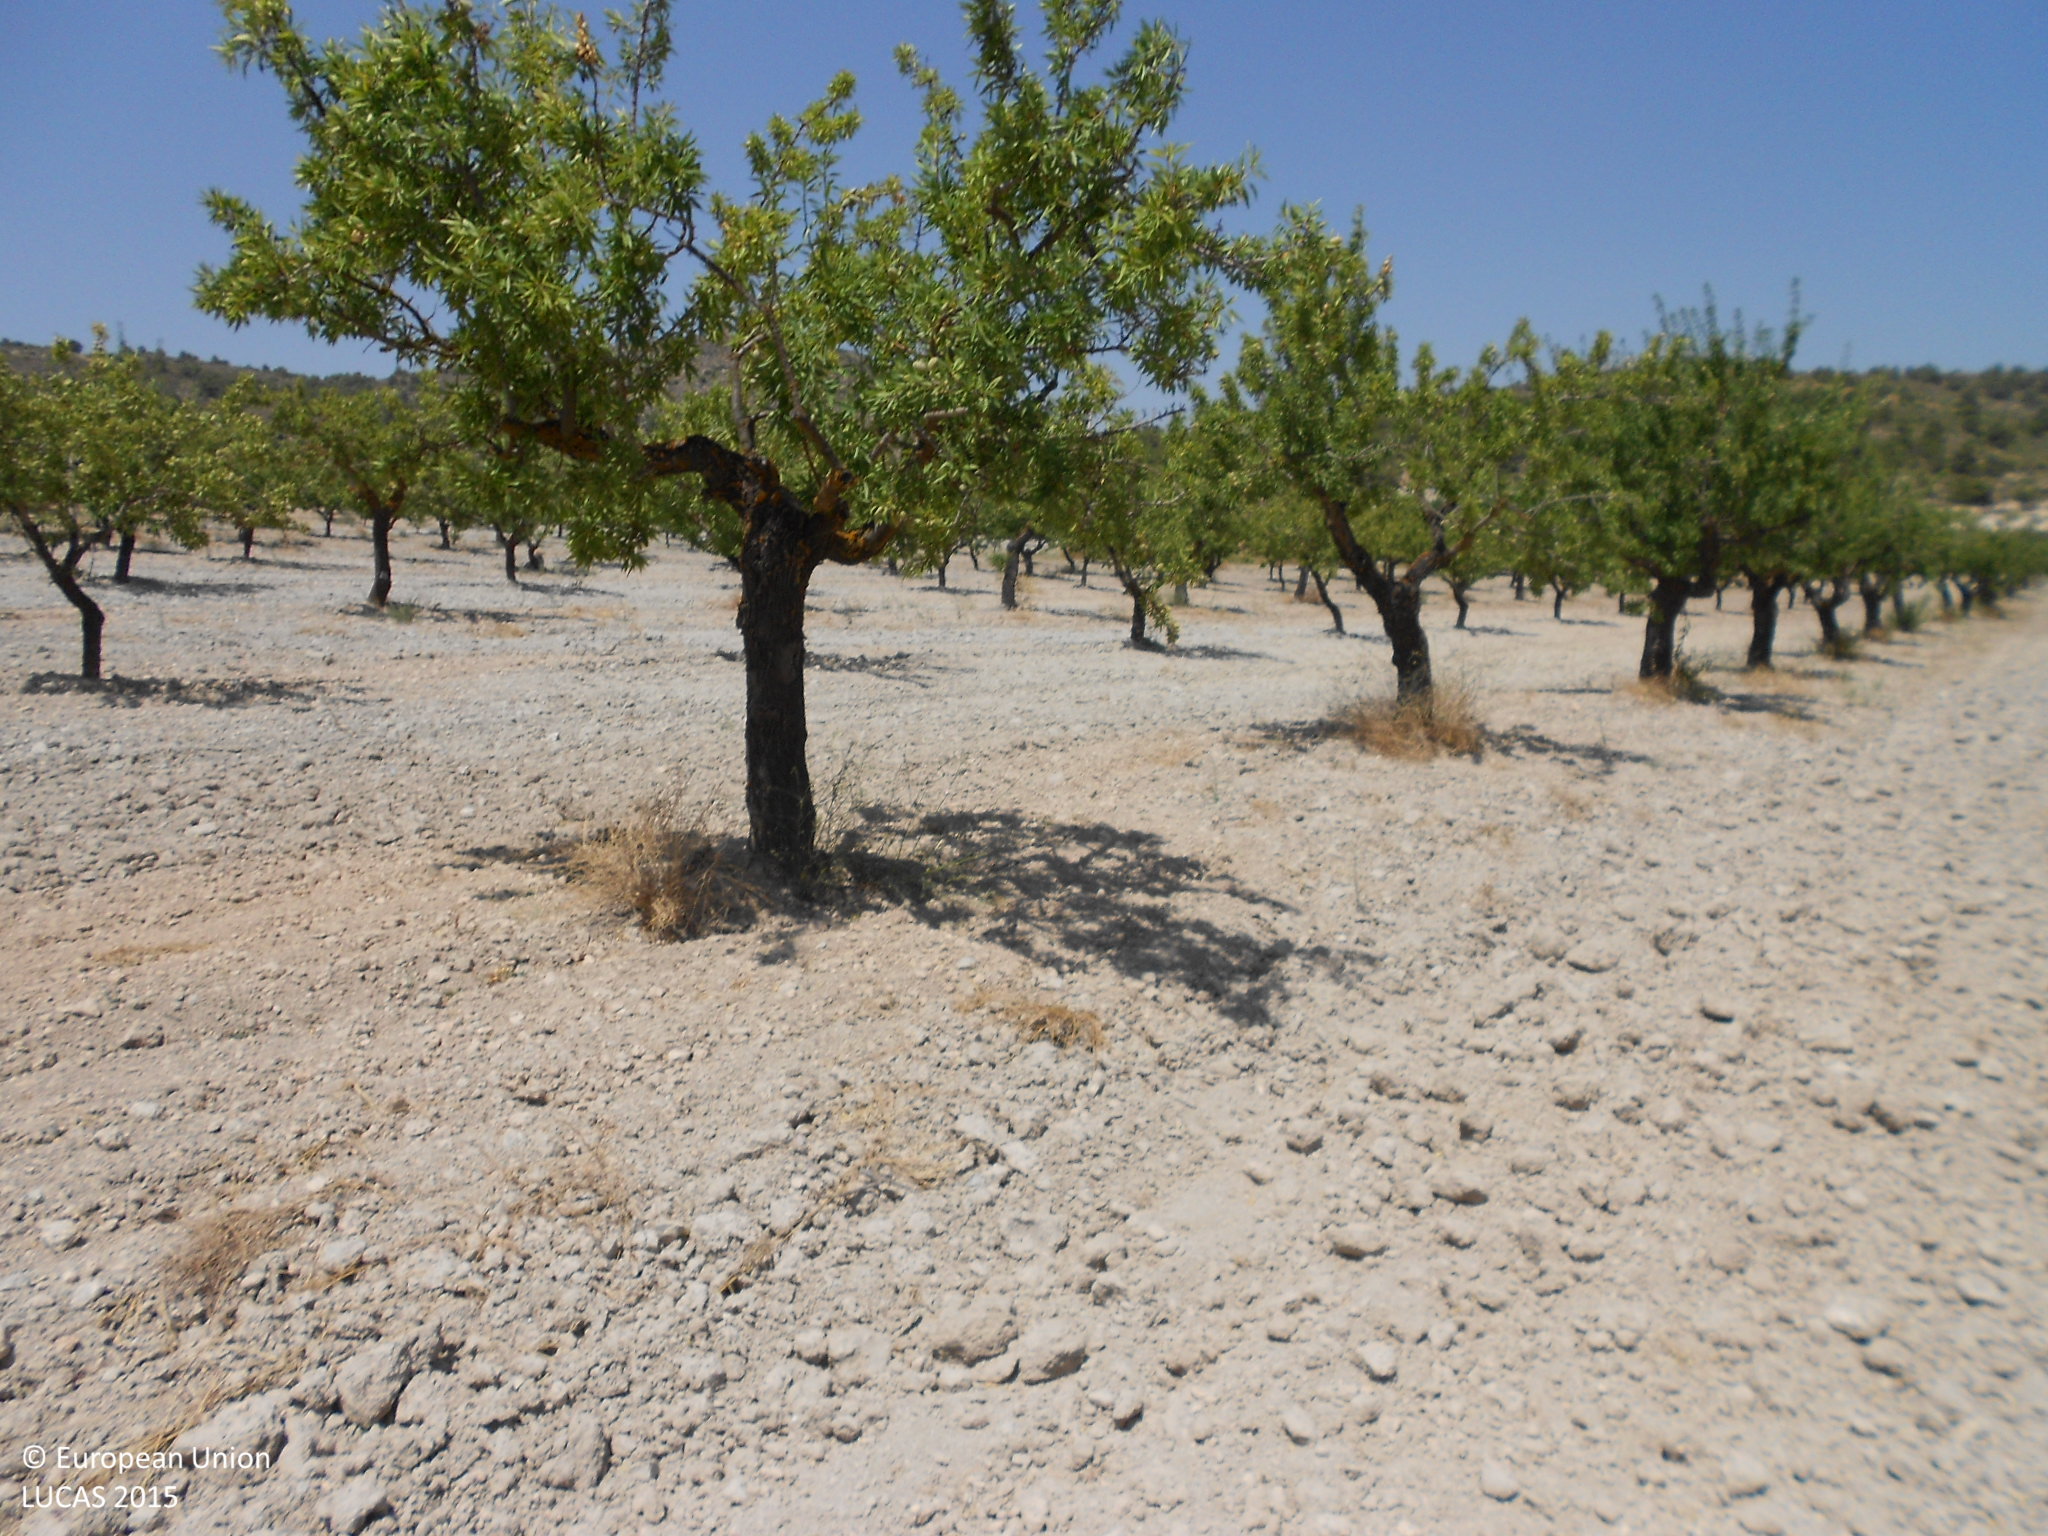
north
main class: Cropland
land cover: Nuts trees
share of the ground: 25 - 50 %
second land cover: Other bare soil
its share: > 75 %
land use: Agriculture (excluding fallow land and kitchen gardens)
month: July
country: ES
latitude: 37.4986
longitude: -2.4157
